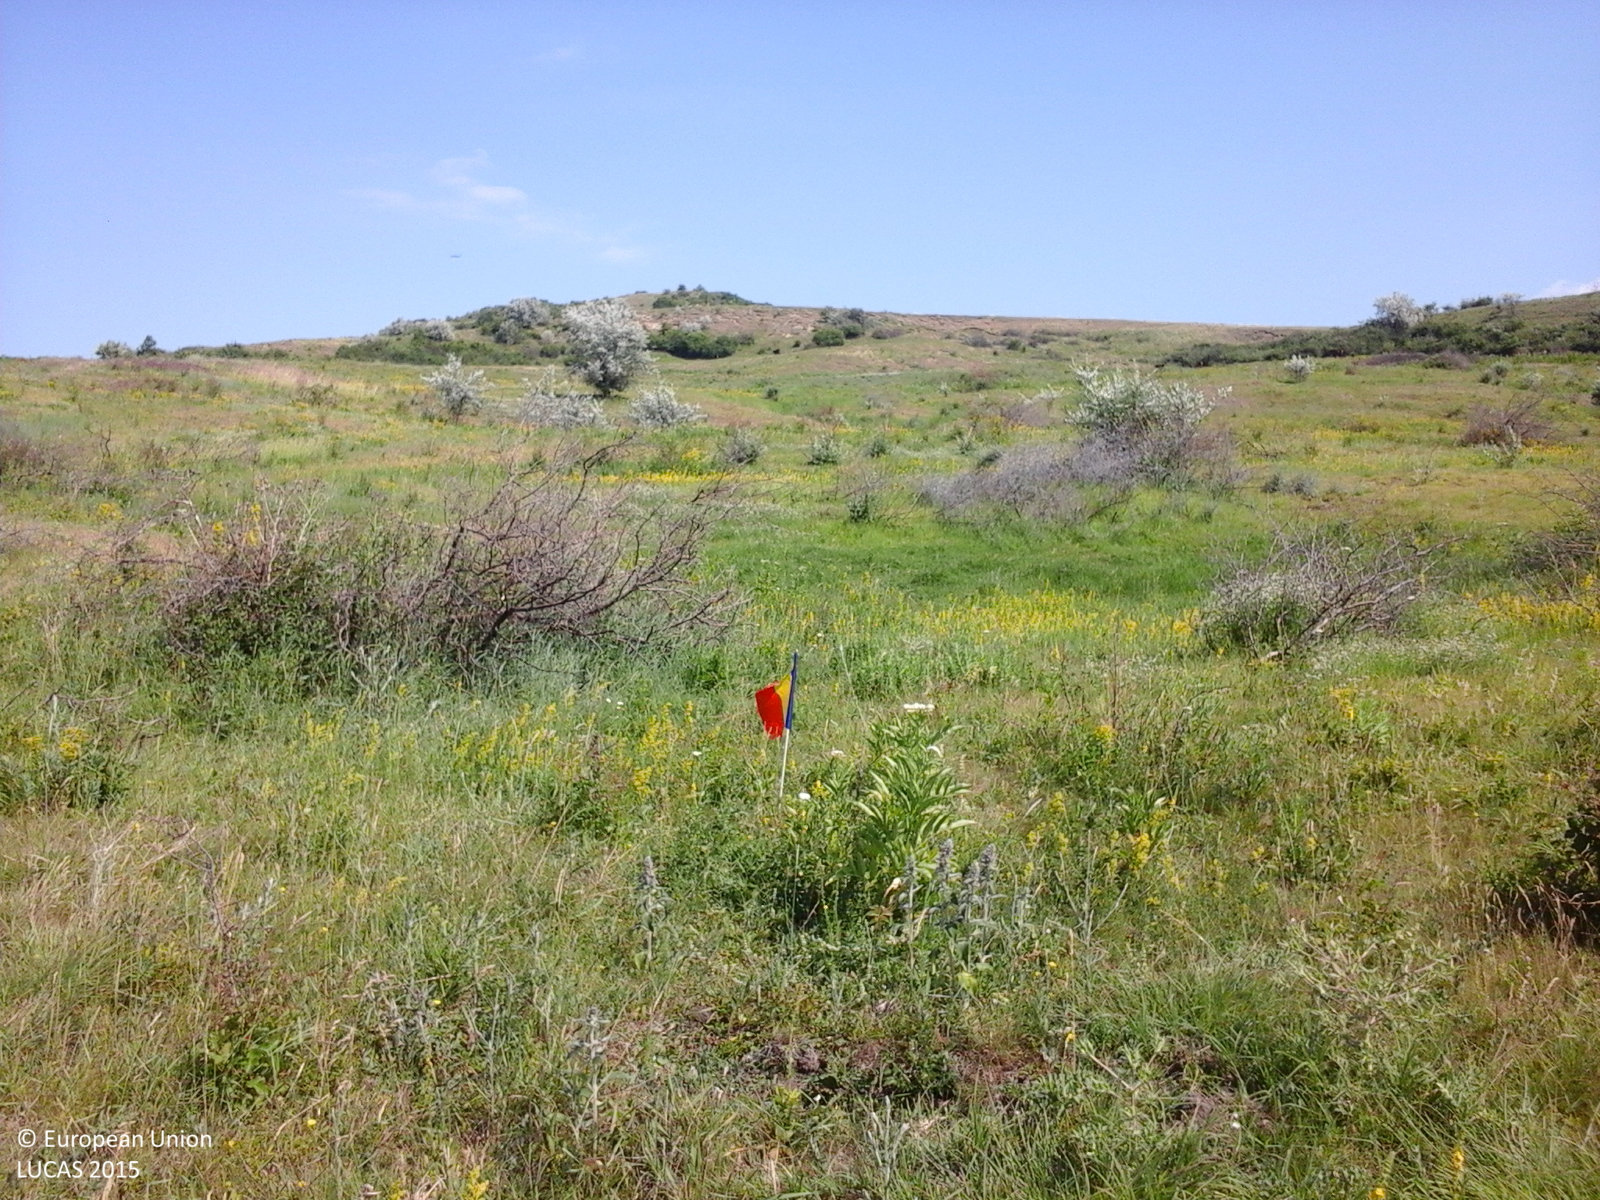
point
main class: Grassland
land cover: Grassland with sparse tree/shrub cover
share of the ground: 25 - 50 %
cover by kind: herbaceous plants 90 %, broadleaved forest trees 5 %, shrubs 5 %
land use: Agriculture (excluding fallow land and kitchen gardens)
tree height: < 5 m
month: June
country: RO
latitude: 46.7489
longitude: 27.9692
